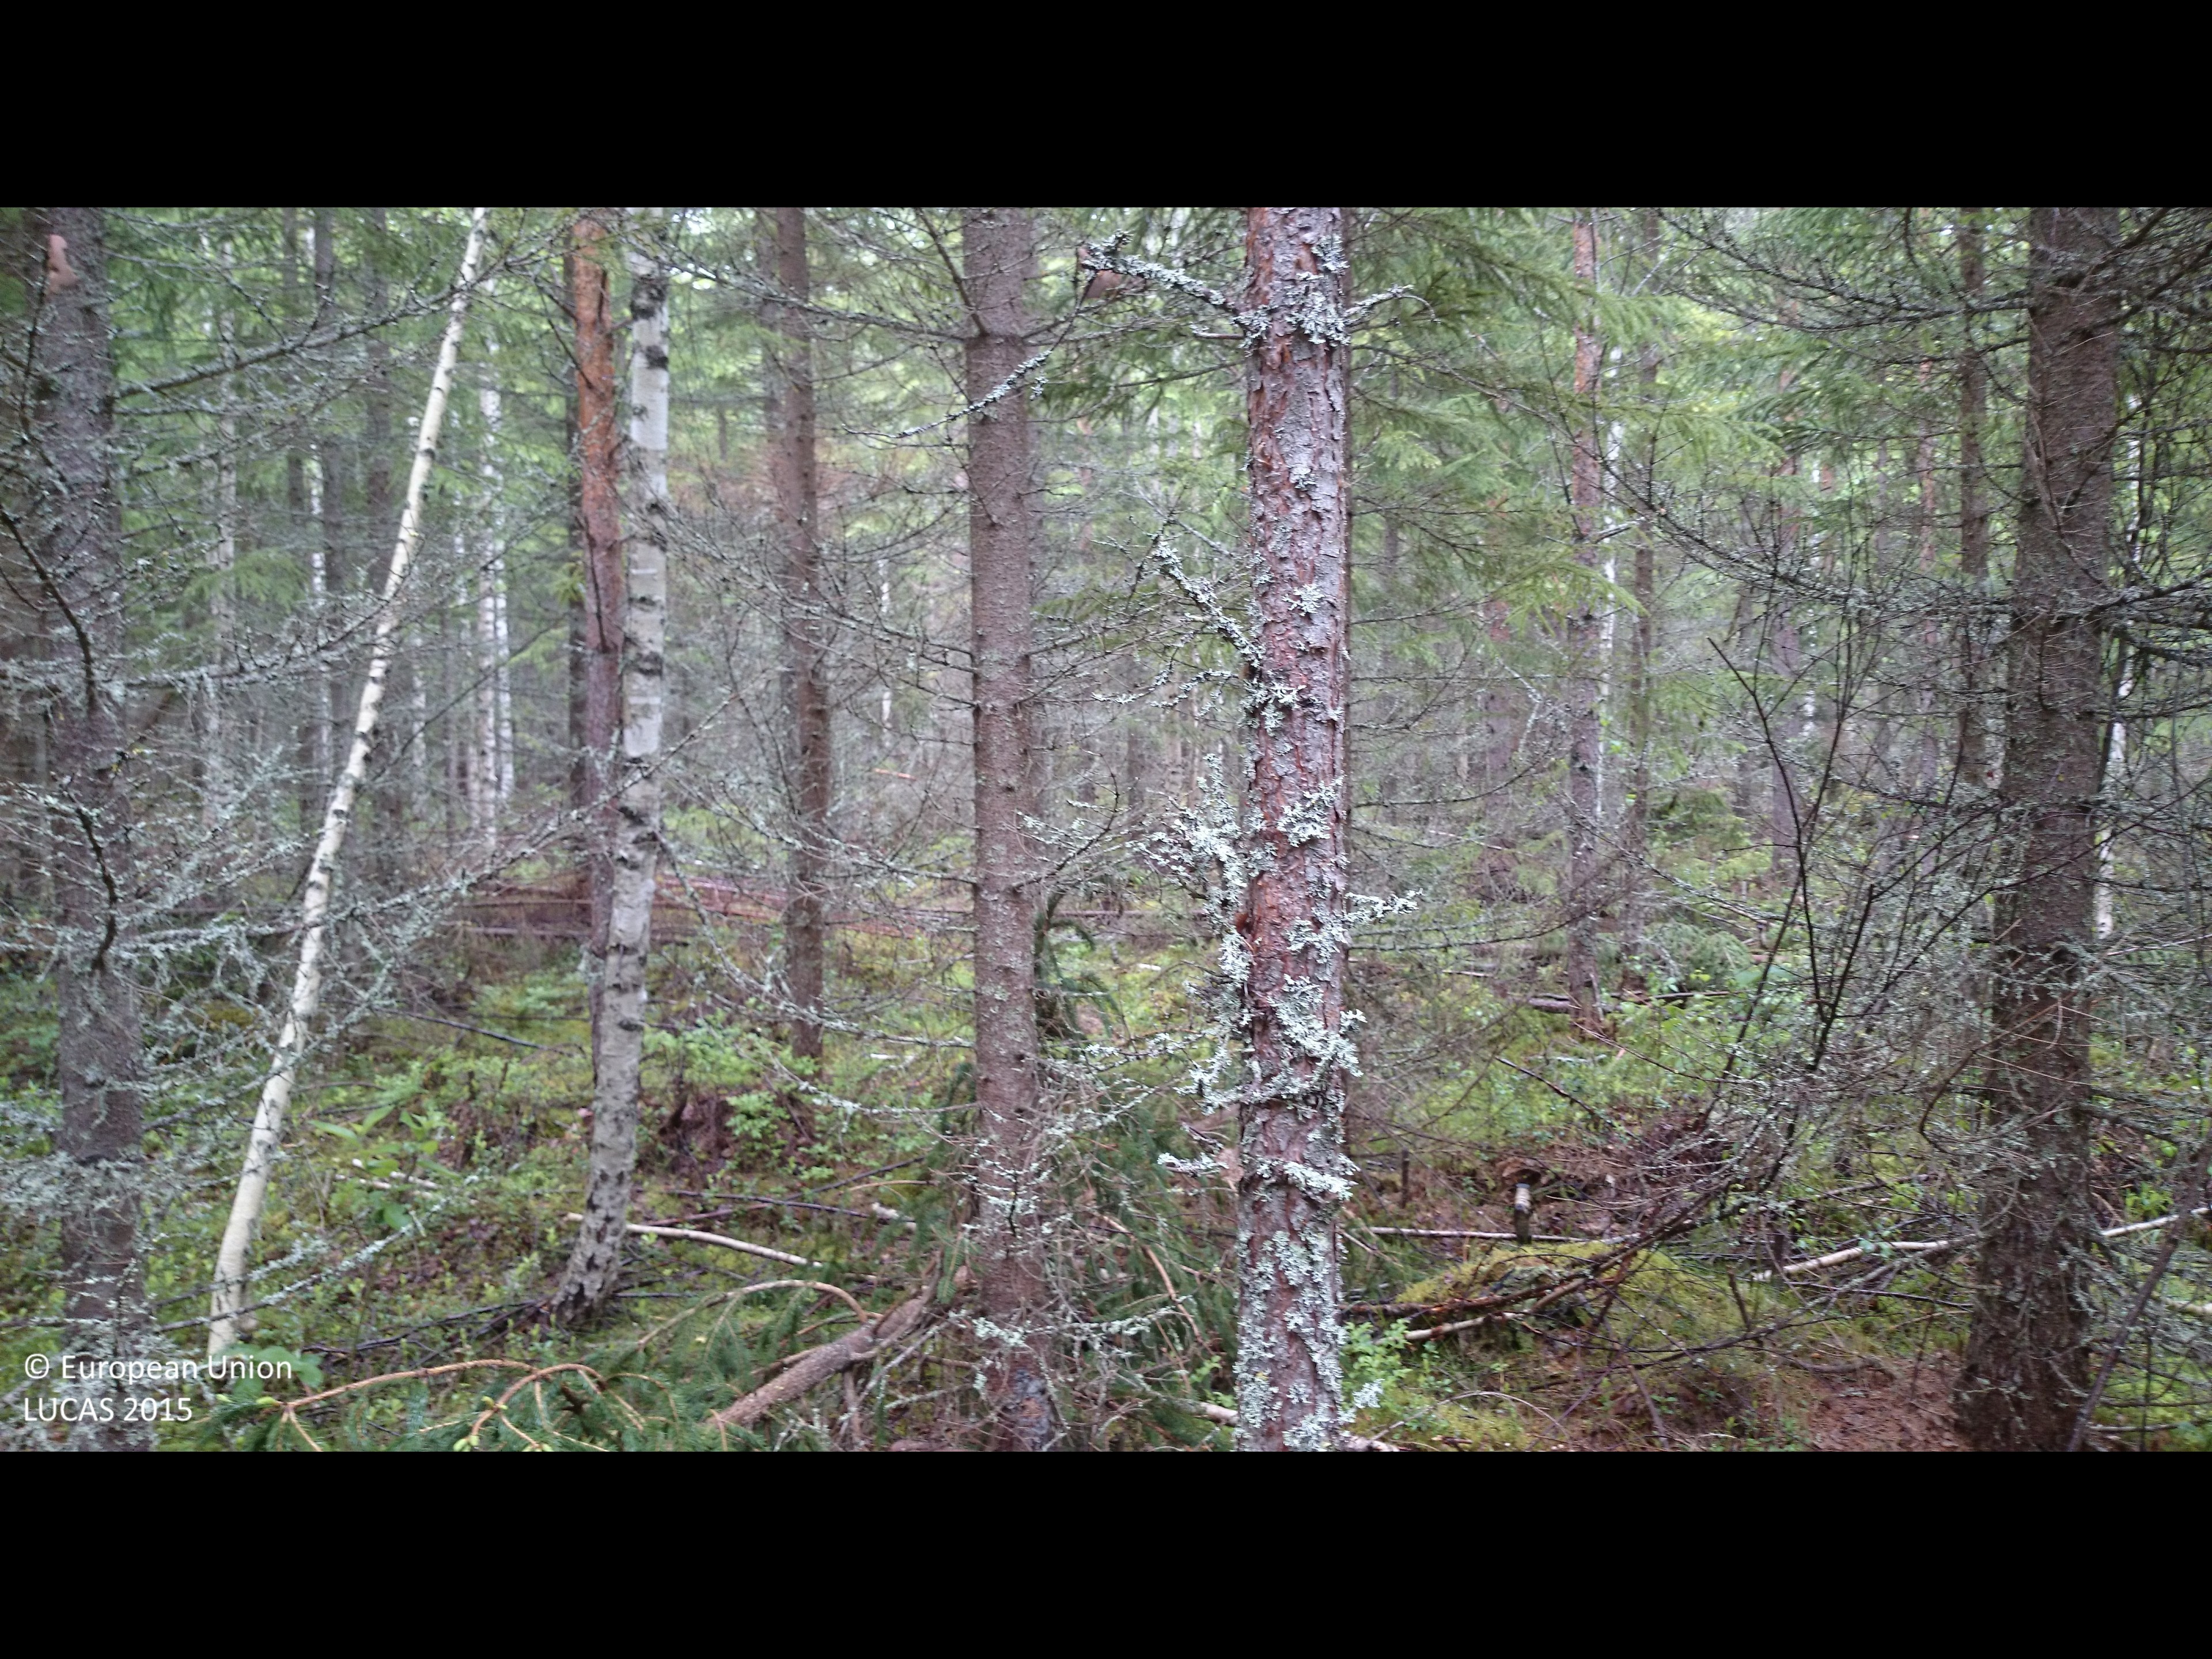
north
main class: Woodland
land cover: Spruce dominated mixed woodland
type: boreal forest
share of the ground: 25 - 50 %
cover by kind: lichens and mosses 35 %, coniferous forest trees 30 %, shrubs 20 %, broadleaved forest trees 15 %
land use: Forestry
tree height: > 5 m
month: June
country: SE
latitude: 61.9883
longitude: 16.7959
